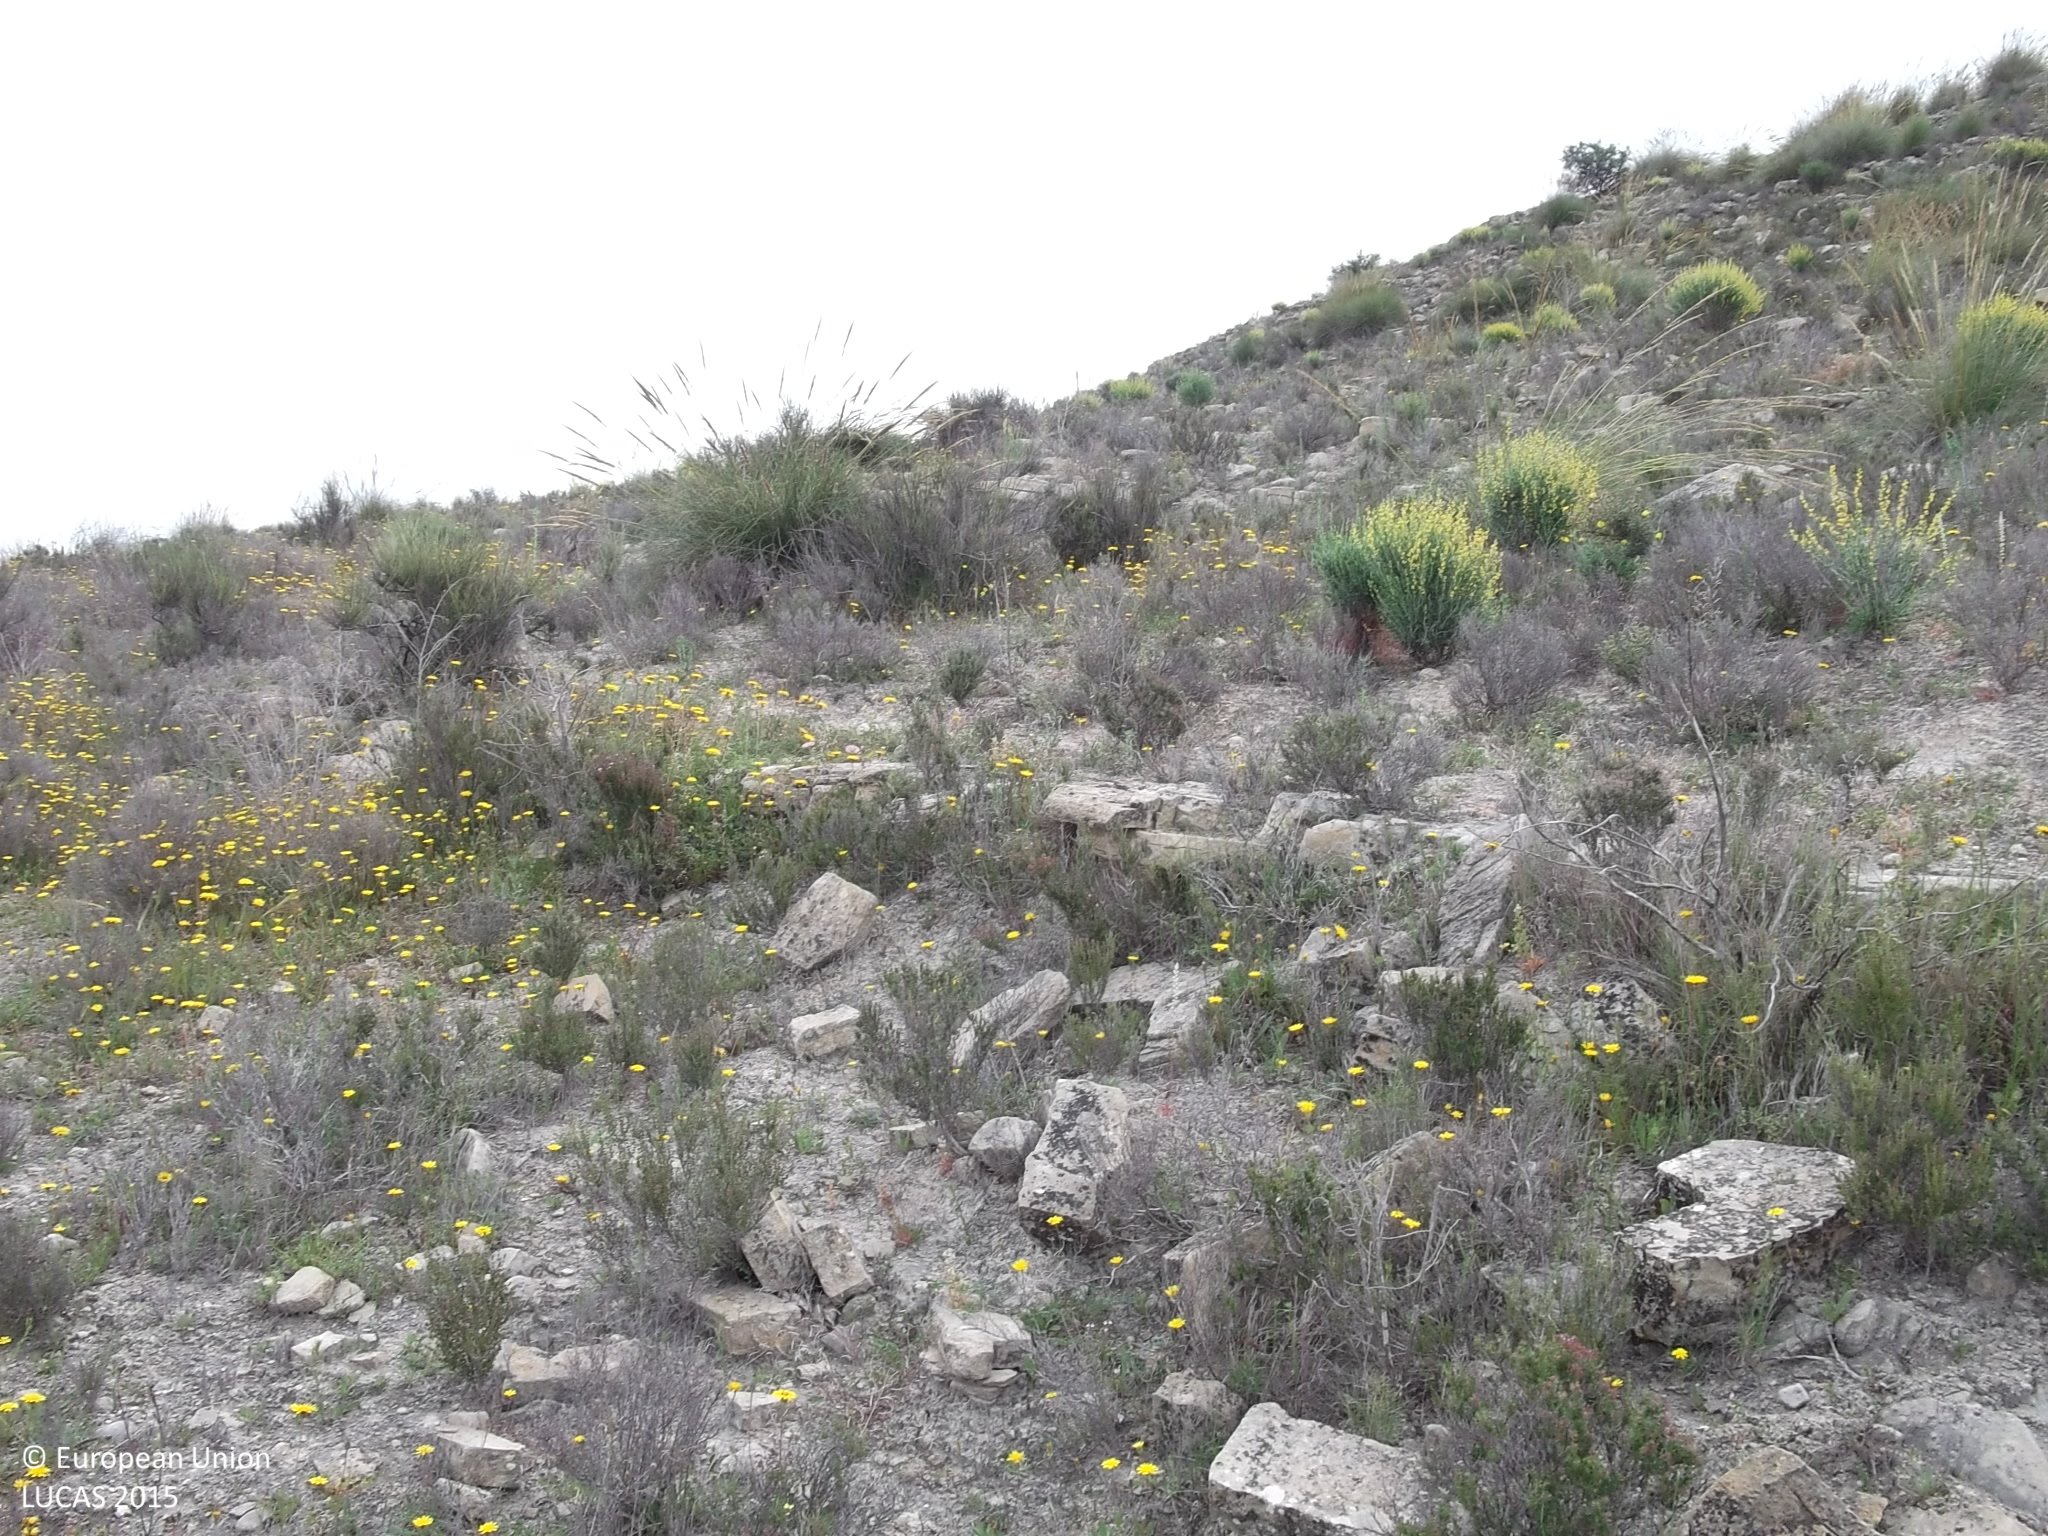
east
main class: Shrubland
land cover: Shrubland without tree cover
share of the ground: 25 - 50 %
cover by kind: herbaceous plants 60 %, shrubs 40 %
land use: Semi-natural and natural areas not in use
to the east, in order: Shrubland without tree cover; Tracks; Shrubland without tree cover; Nuts trees; Shrubland without tree cover; Nuts trees; Shrubland without tree cover
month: April
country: ES
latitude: 37.9767
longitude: -1.3806
